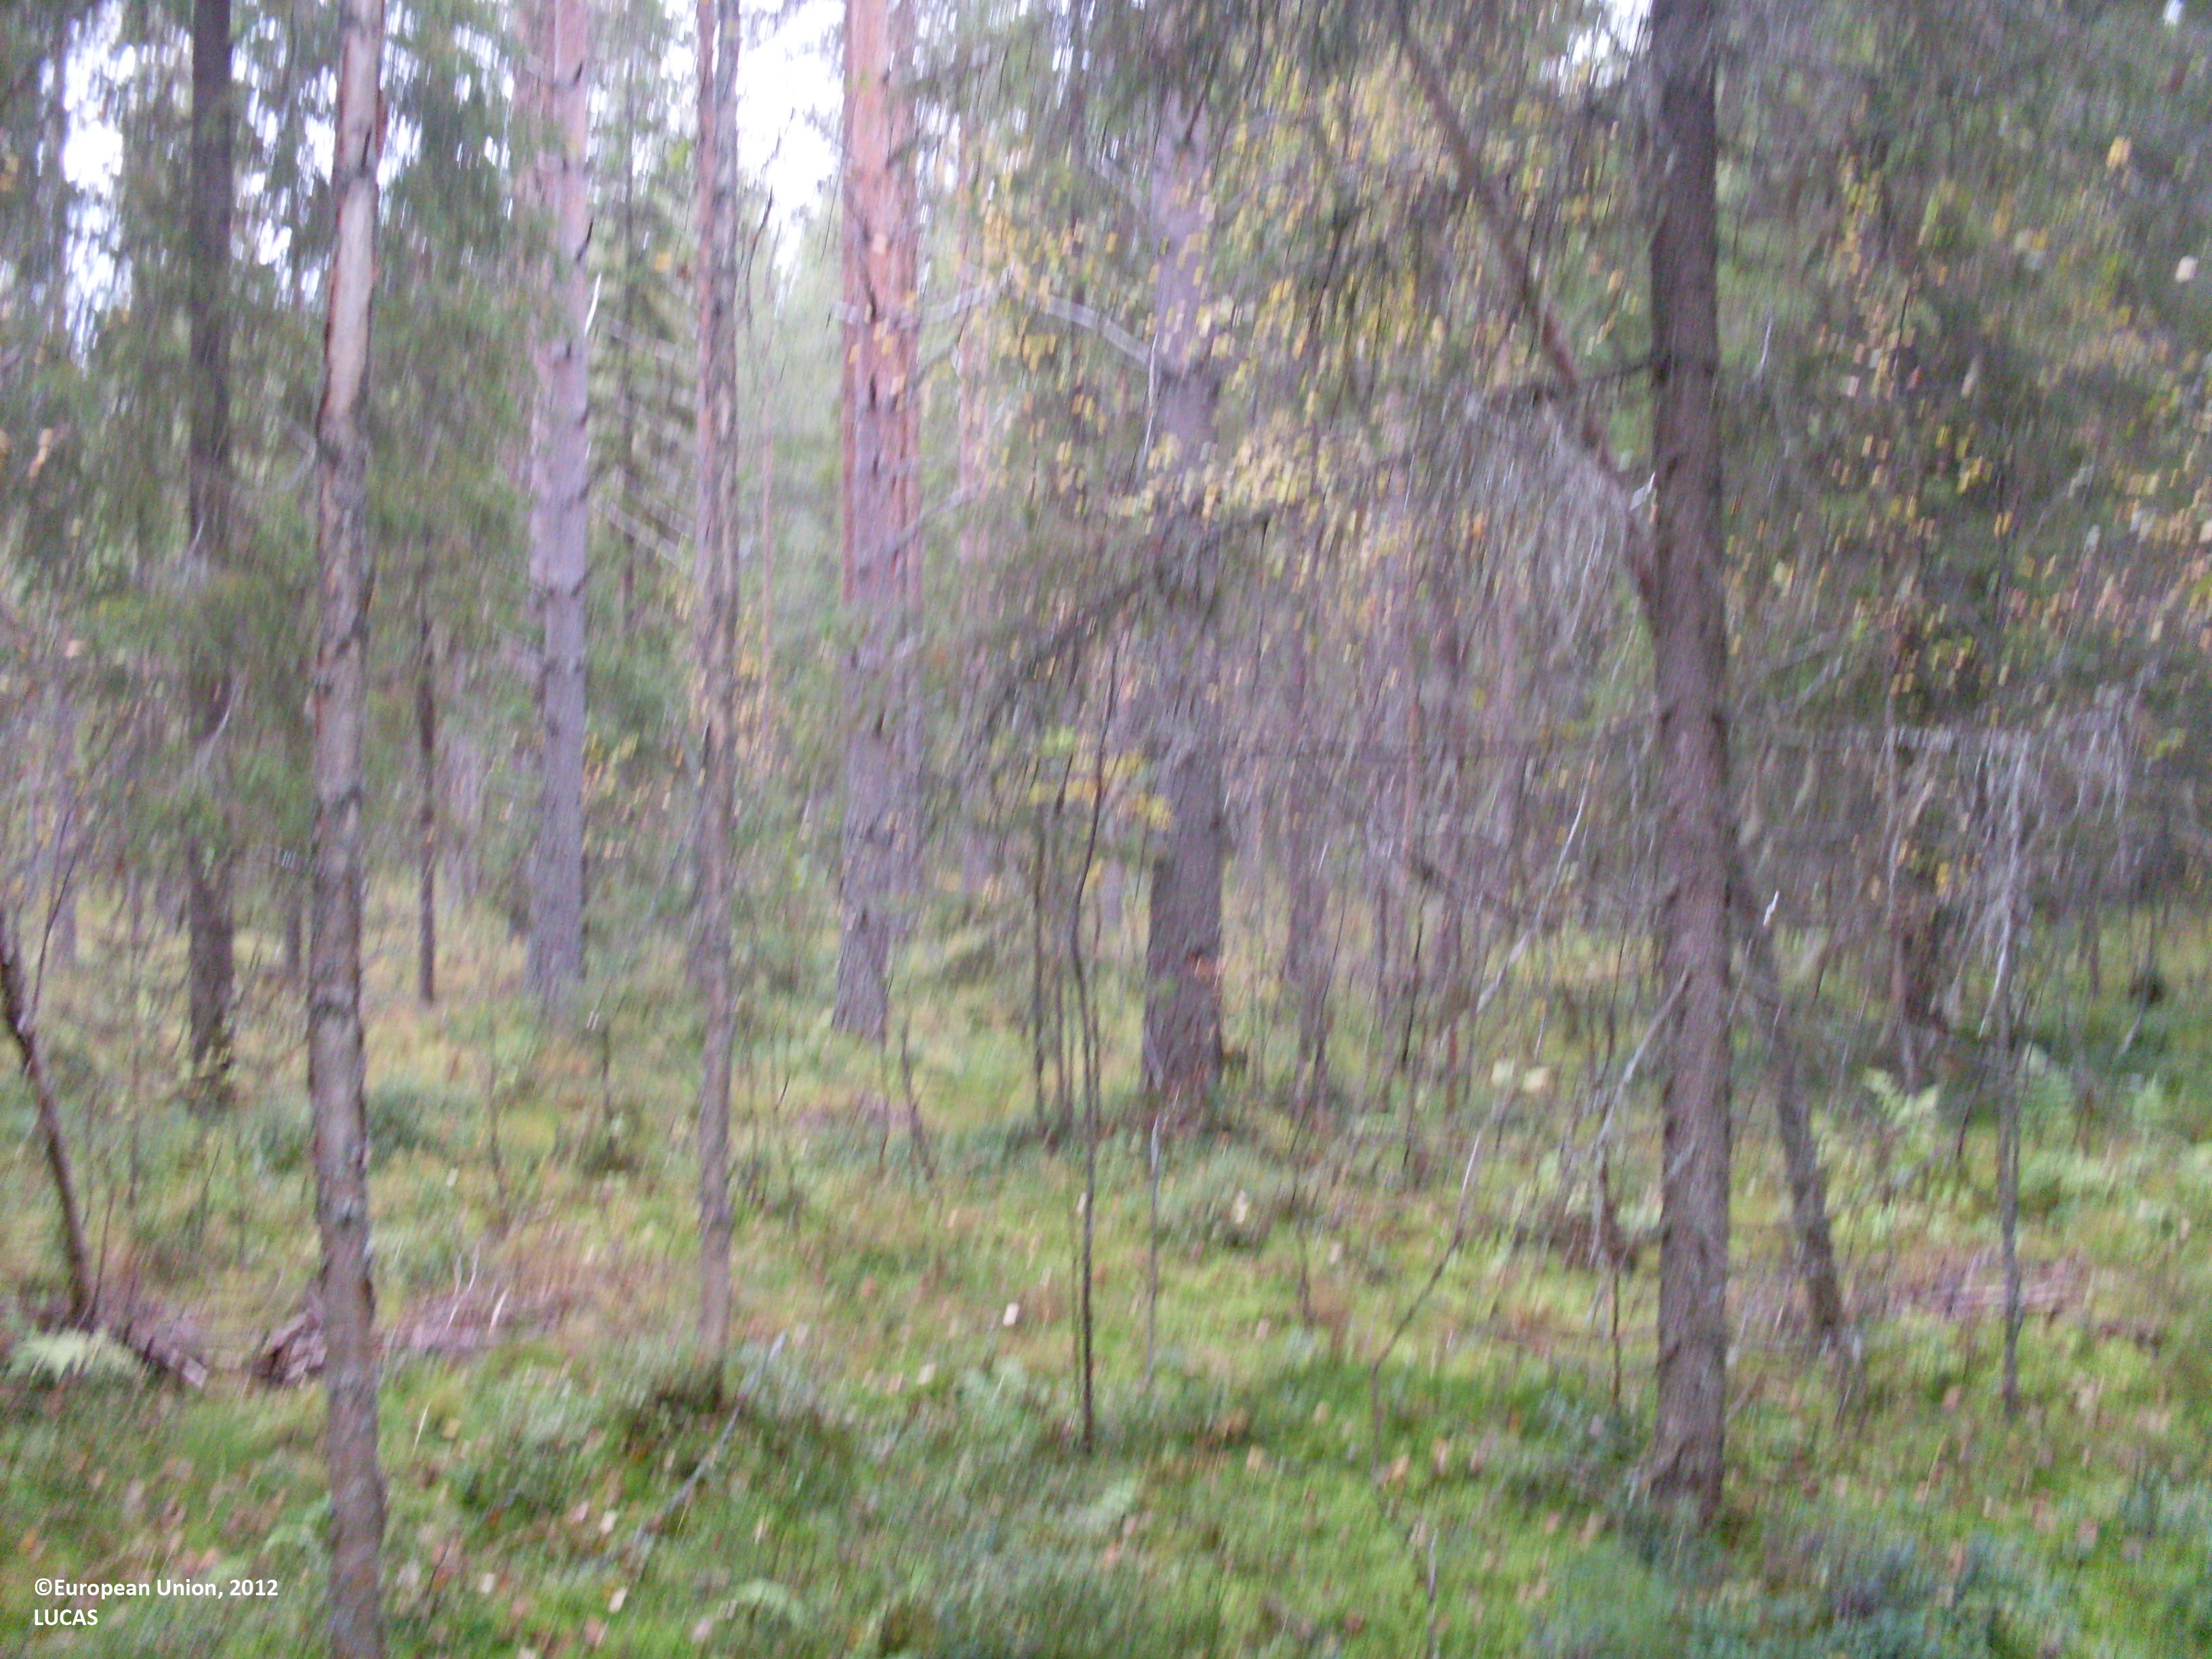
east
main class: Woodland
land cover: Spruce dominated mixed woodland
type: boreal forest
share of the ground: 50 - 75 %
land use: Forestry
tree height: > 5 m
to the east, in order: Spruce dominated mixed woodland; Inland water bodies
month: September
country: FI
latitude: 64.1501
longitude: 28.3684
